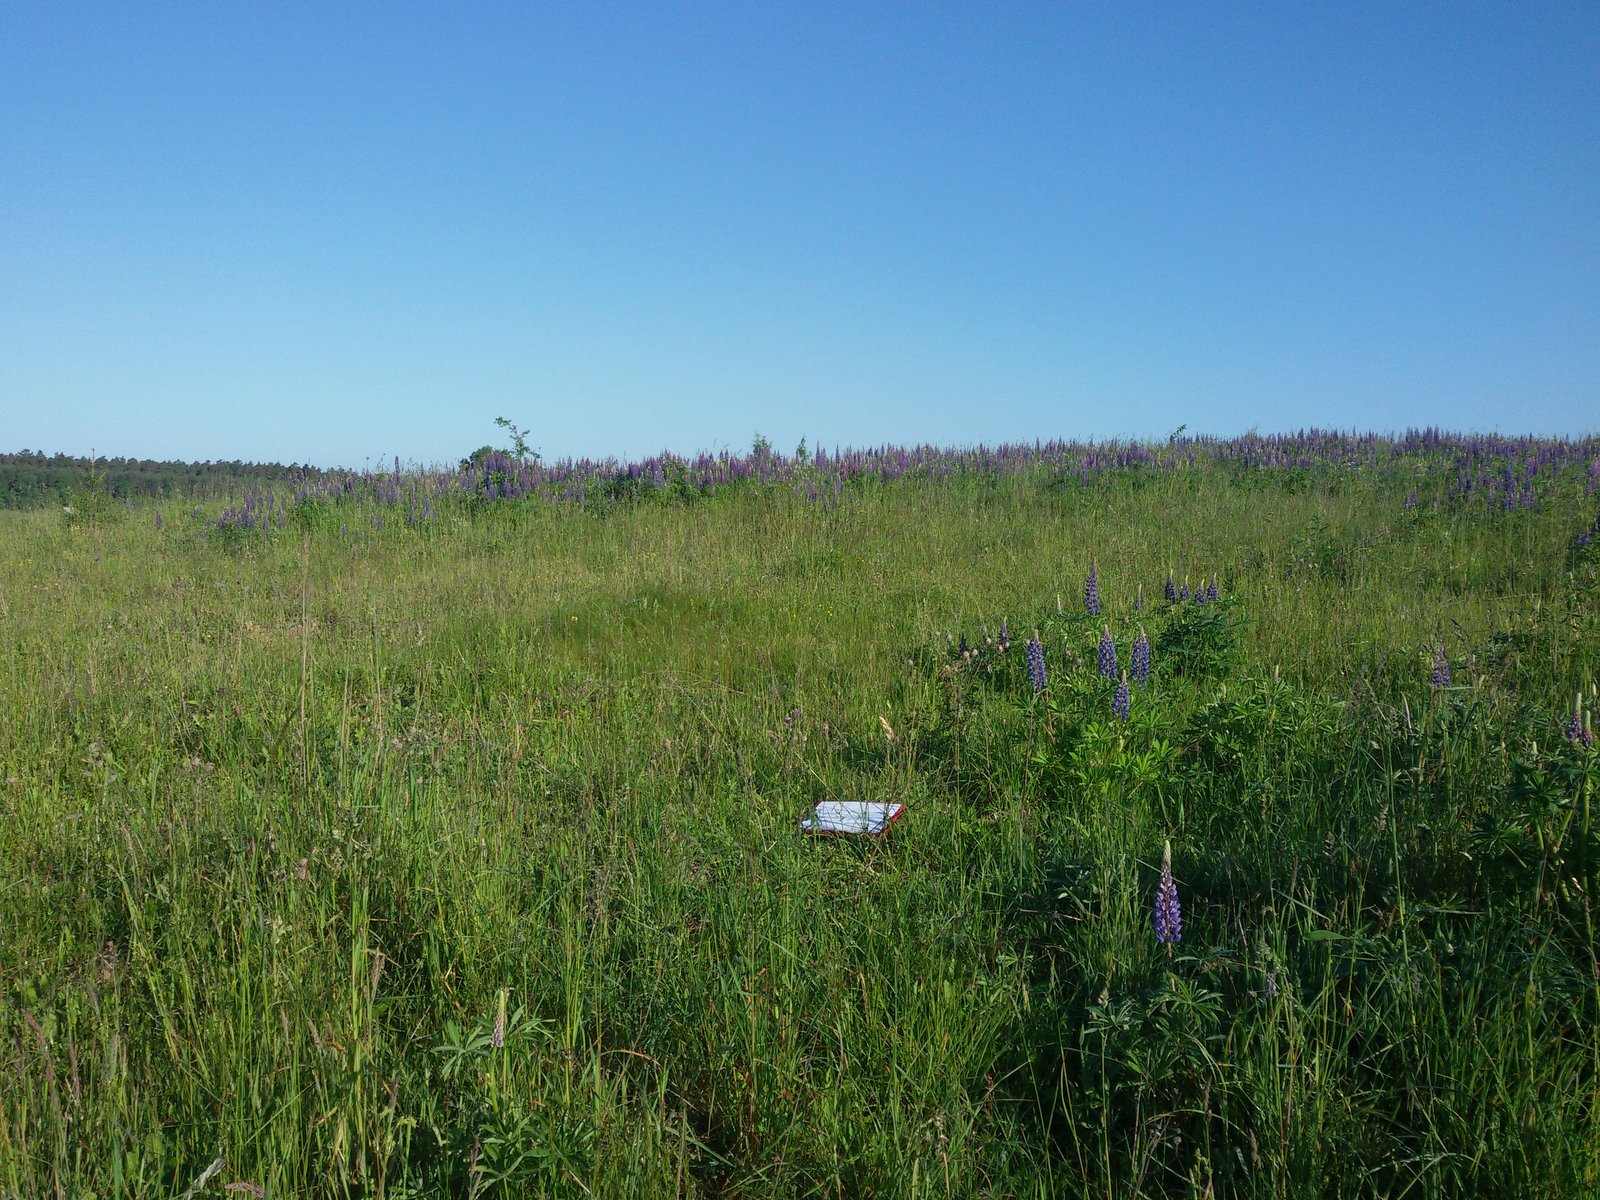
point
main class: Grassland
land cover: Grassland with sparse tree/shrub cover
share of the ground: > 75 %
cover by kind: herbaceous plants 90 %, broadleaved forest trees 5 %, shrubs 5 %
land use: Semi-natural and natural areas not in use
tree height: < 5 m
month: June
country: PL
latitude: 54.0140
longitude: 22.2540
